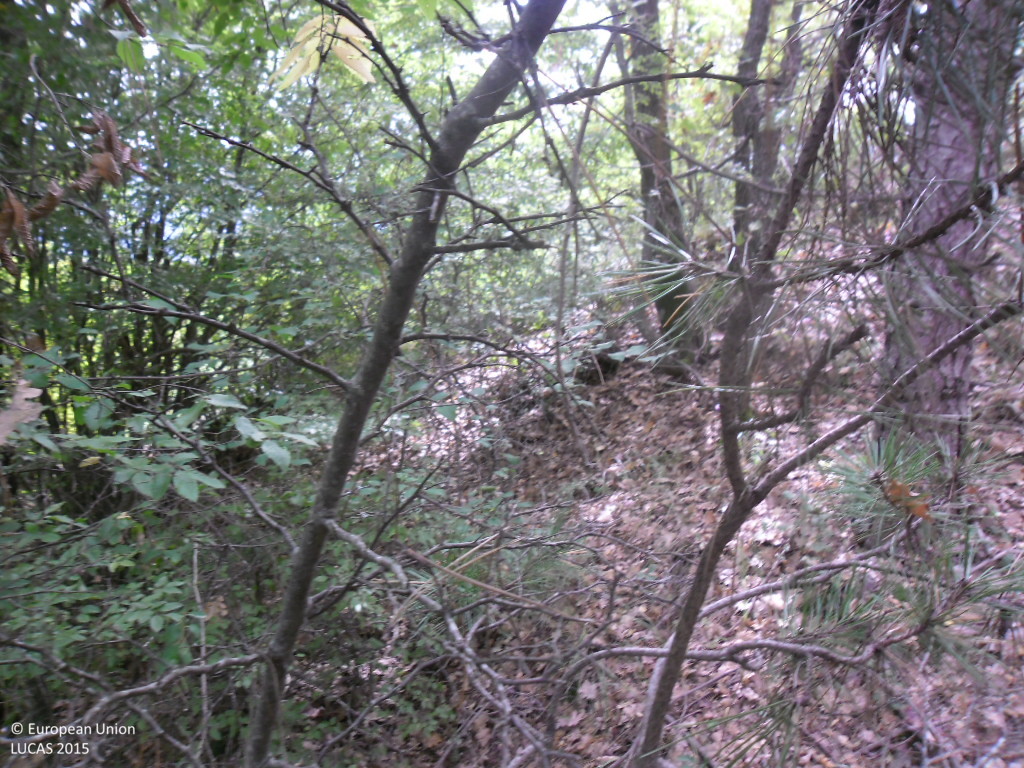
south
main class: Woodland
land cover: Other mixed woodland
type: hemiboreal forest and nemoral coniferous forest and mixed broadleaved-coniferous forest
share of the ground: > 75 %
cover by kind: coniferous forest trees 75 %, broadleaved forest trees 25 %
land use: Forestry
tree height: > 5 m
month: September
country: BG
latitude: 41.4014
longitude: 23.0671
